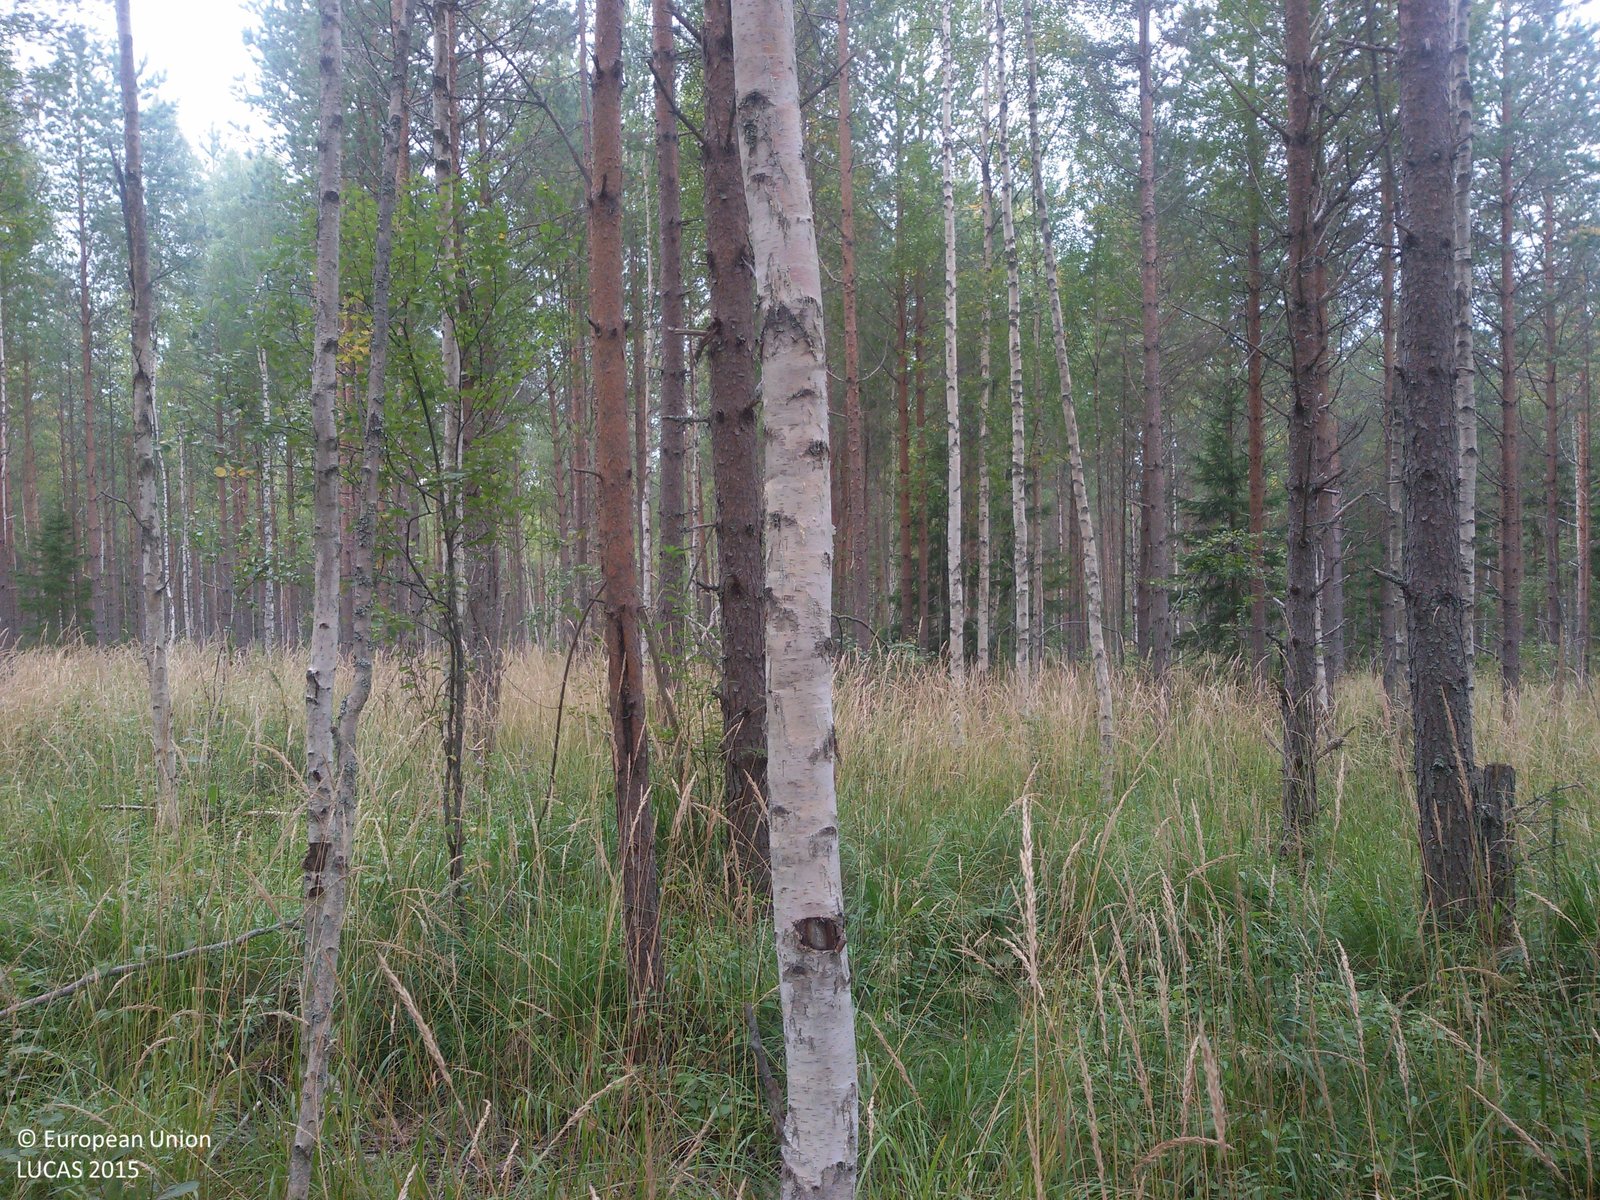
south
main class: Woodland
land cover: Pine dominated mixed woodland
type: boreal forest
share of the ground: > 75 %
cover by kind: coniferous forest trees 40 %, broadleaved forest trees 30 %, shrubs 25 %, lichens and mosses 5 %
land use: Forestry
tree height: > 5 m
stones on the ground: < 10 %
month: September
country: SE
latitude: 60.8597
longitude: 15.2332
